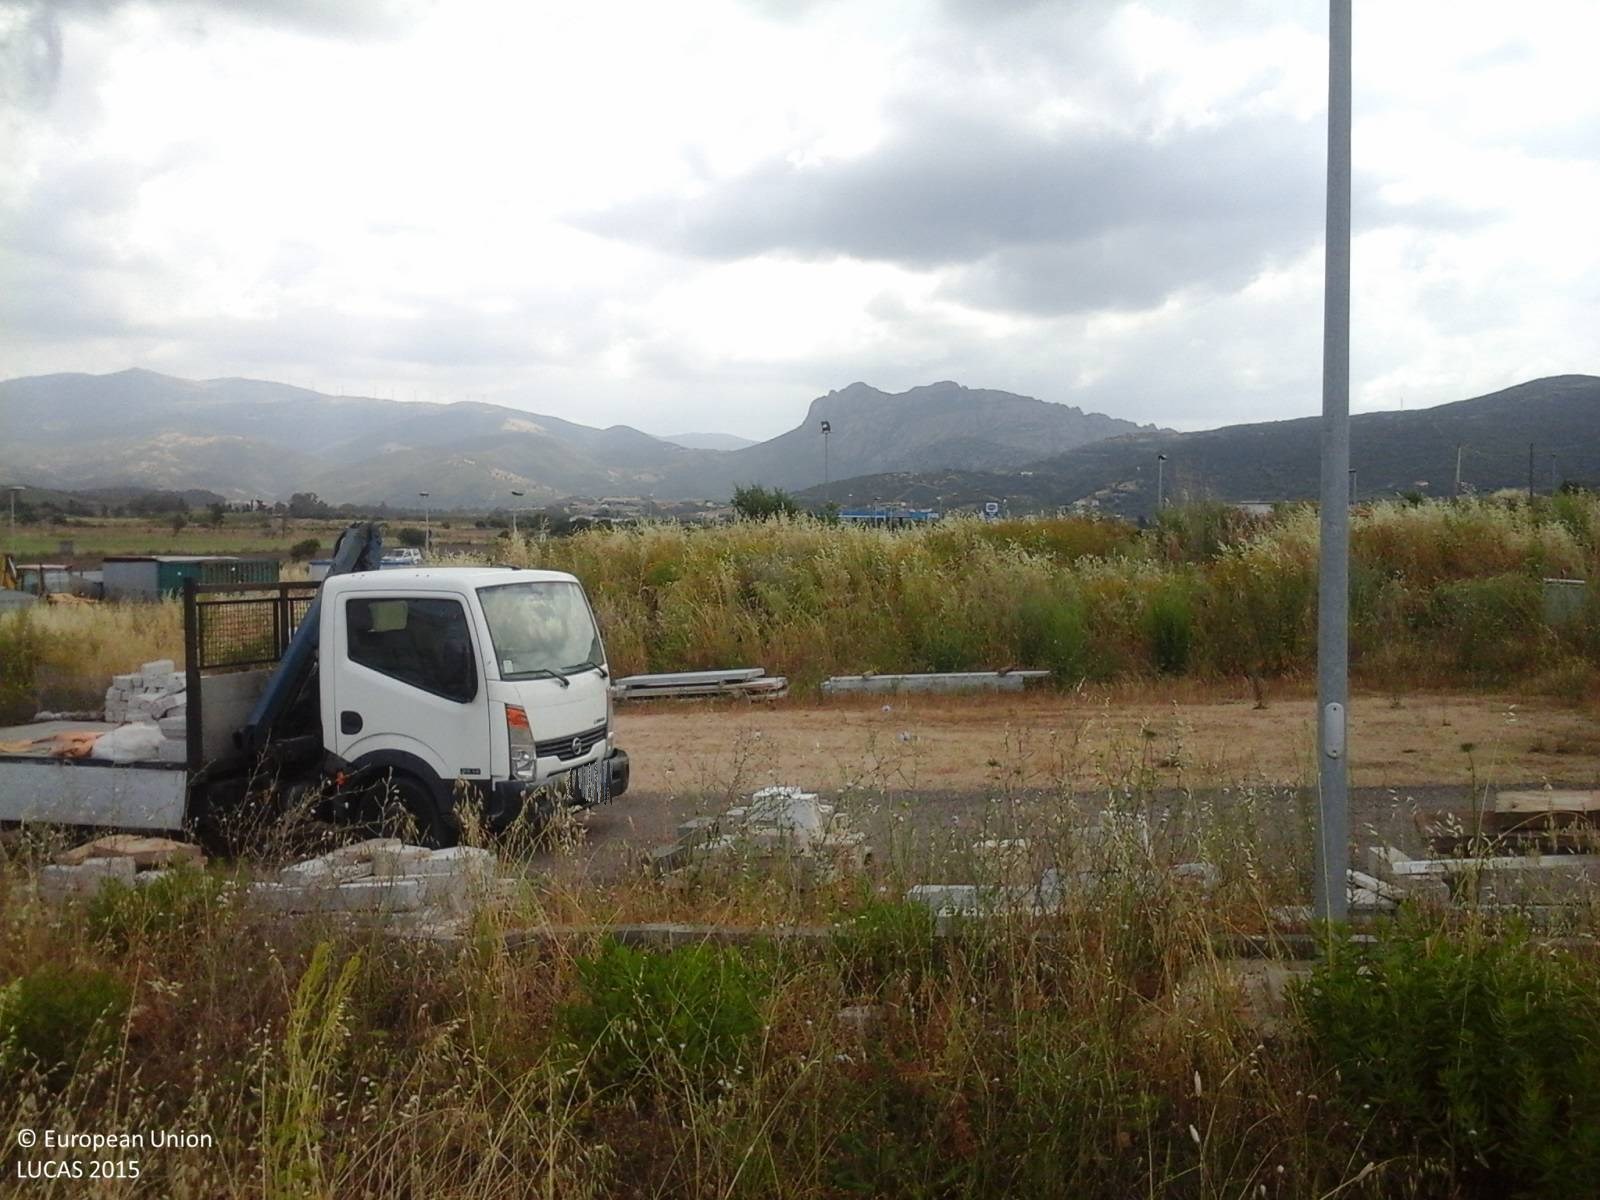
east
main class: Grassland
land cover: Grassland without tree/shrub cover
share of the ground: > 75 %
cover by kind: herbaceous plants 95 %, shrubs 5 %
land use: Semi-natural and natural areas not in use
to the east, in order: Grassland without tree/shrub cover; Artificial constructions in urban areas; Grassland without tree/shrub cover; Other bare soil; Grass margins; Durum wheat
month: May
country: IT
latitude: 40.9122
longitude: 8.8537
